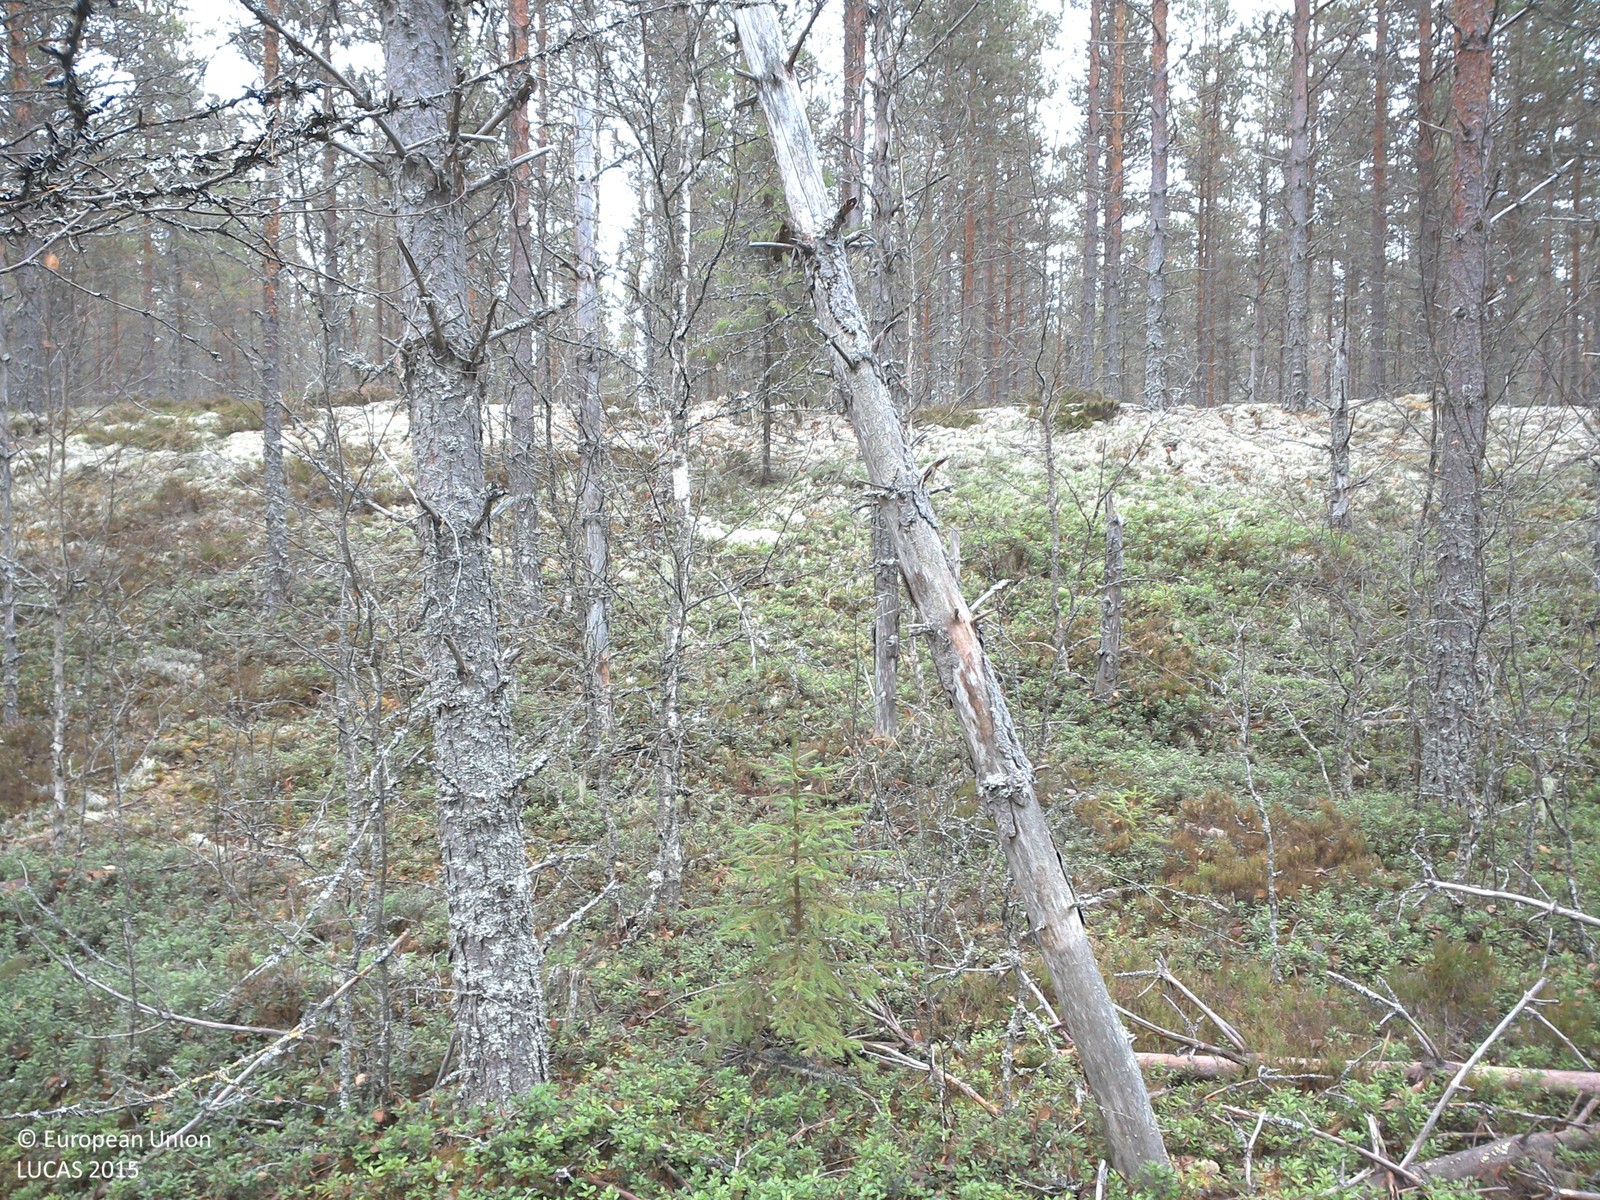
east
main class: Woodland
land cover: Pine dominated coniferous woodland
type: boreal forest
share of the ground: > 75 %
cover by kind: coniferous forest trees 65 %, shrubs 20 %, broadleaved forest trees 15 %
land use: Forestry
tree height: > 5 m
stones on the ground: < 10 %
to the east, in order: Pine dominated coniferous woodland; Grass margins; Paved roads, cycling and walking lanes; Grass margins; Pine dominated coniferous woodland
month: November
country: SE
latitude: 60.1726
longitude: 14.1890
